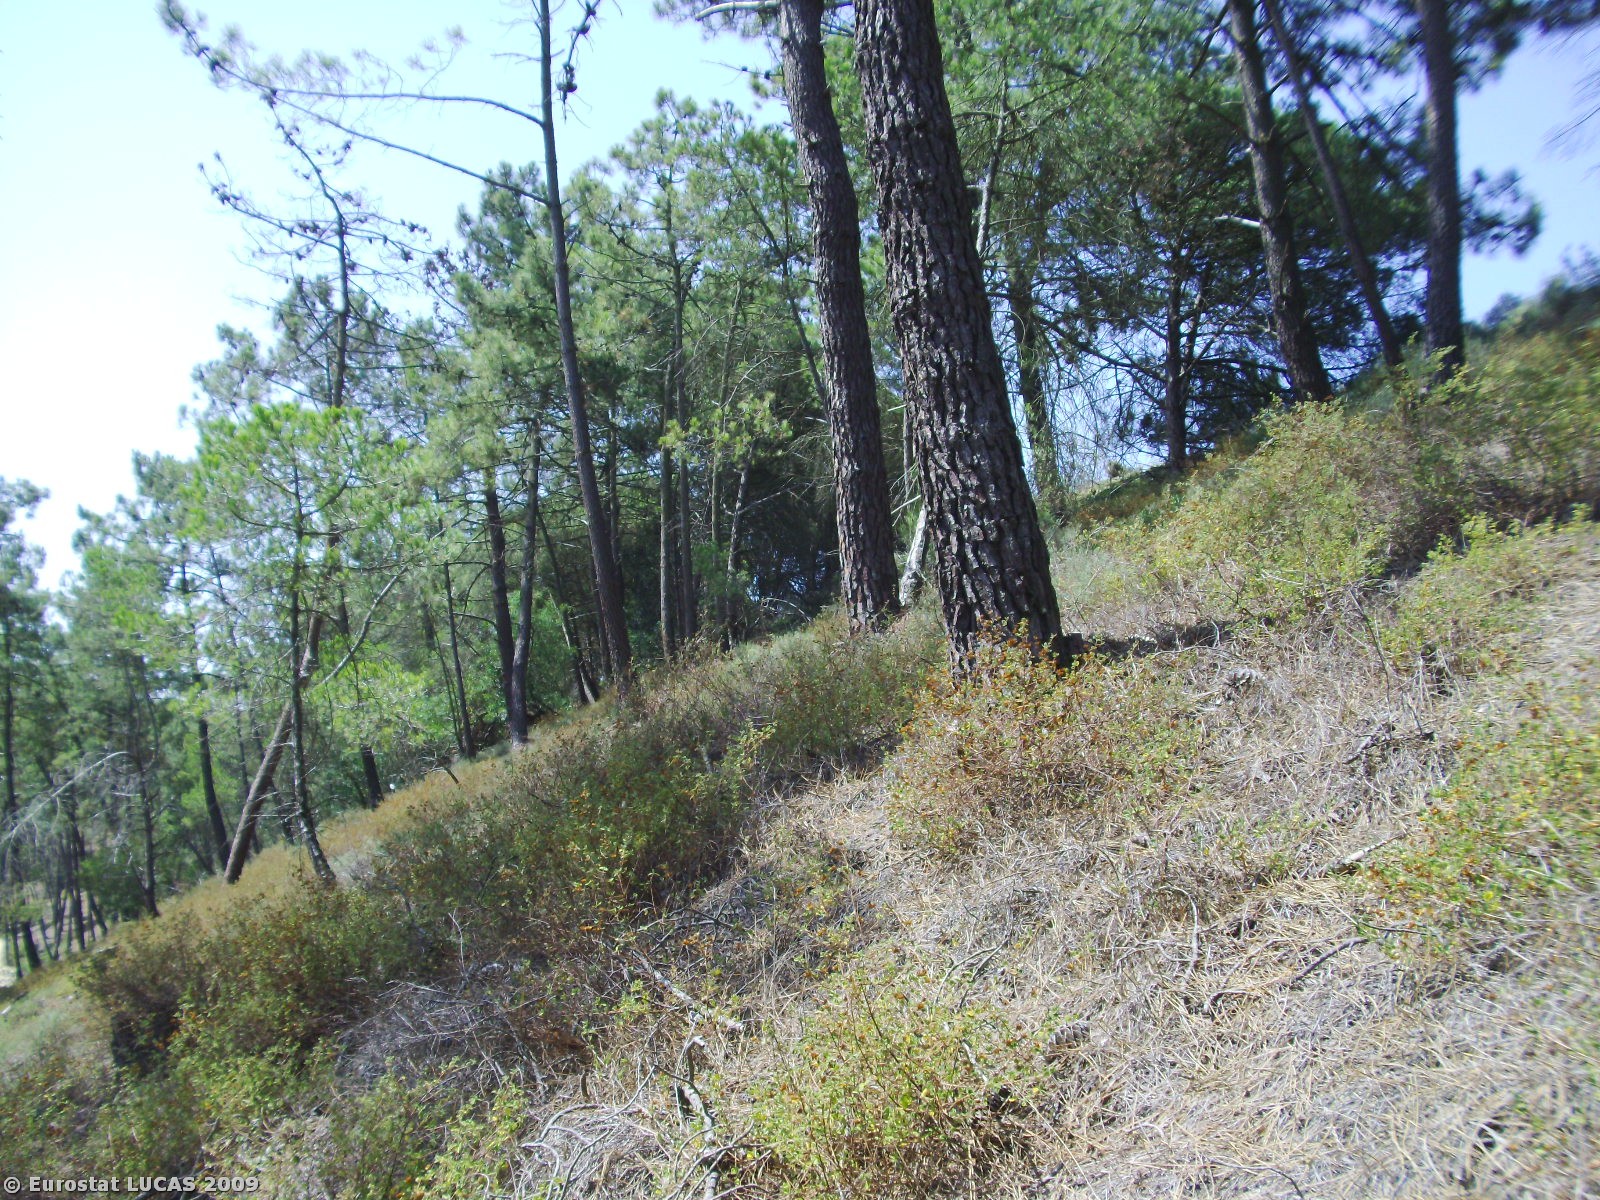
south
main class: Woodland
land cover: Coniferous woodland
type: coniferous forest of the mediterranean region
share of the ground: 25 - 50 %
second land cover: Spontaneously vegetated surfaces
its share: 50 - 75 %
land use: Forestry
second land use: Unused
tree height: > 5 m
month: July
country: PT
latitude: 38.5587
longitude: -9.1801
